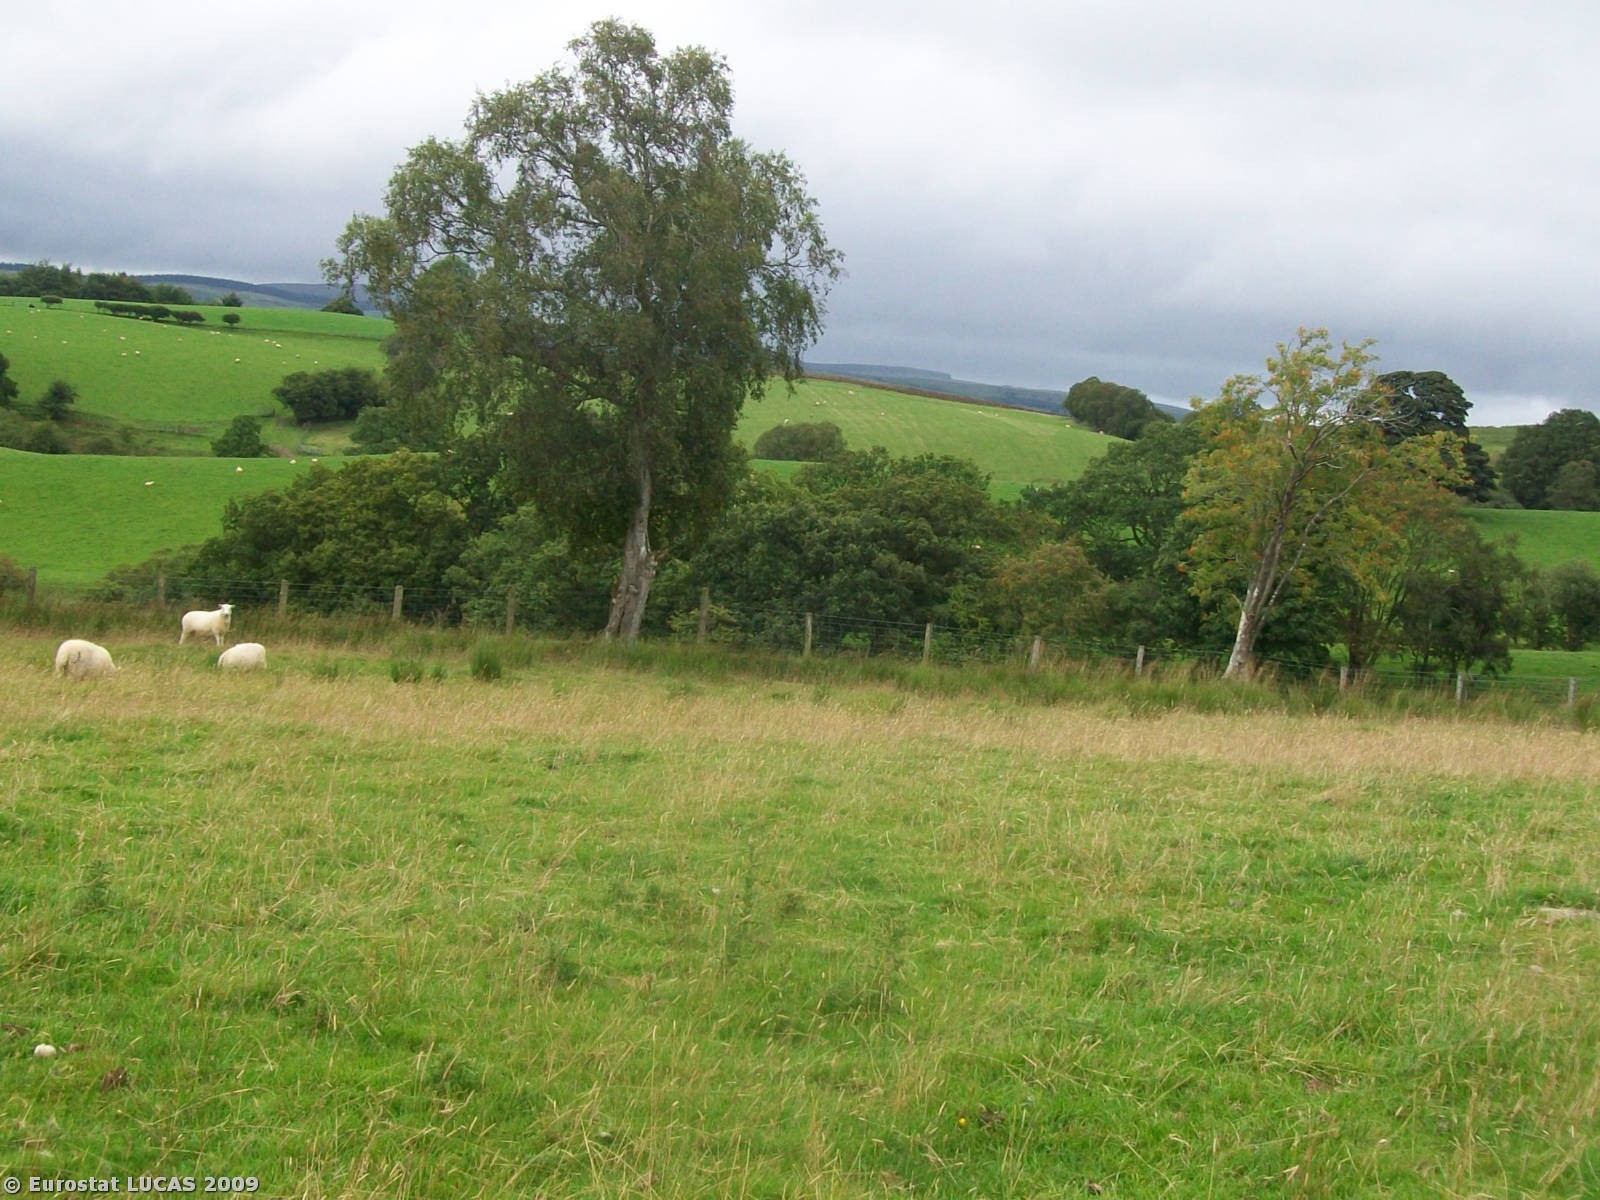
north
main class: Grassland
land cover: Grassland without tree/shrub cover
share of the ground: > 75 %
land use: Agriculture (excluding fallow land and kitchen gardens)
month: August
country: GB
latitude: 52.7264
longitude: -3.3937
